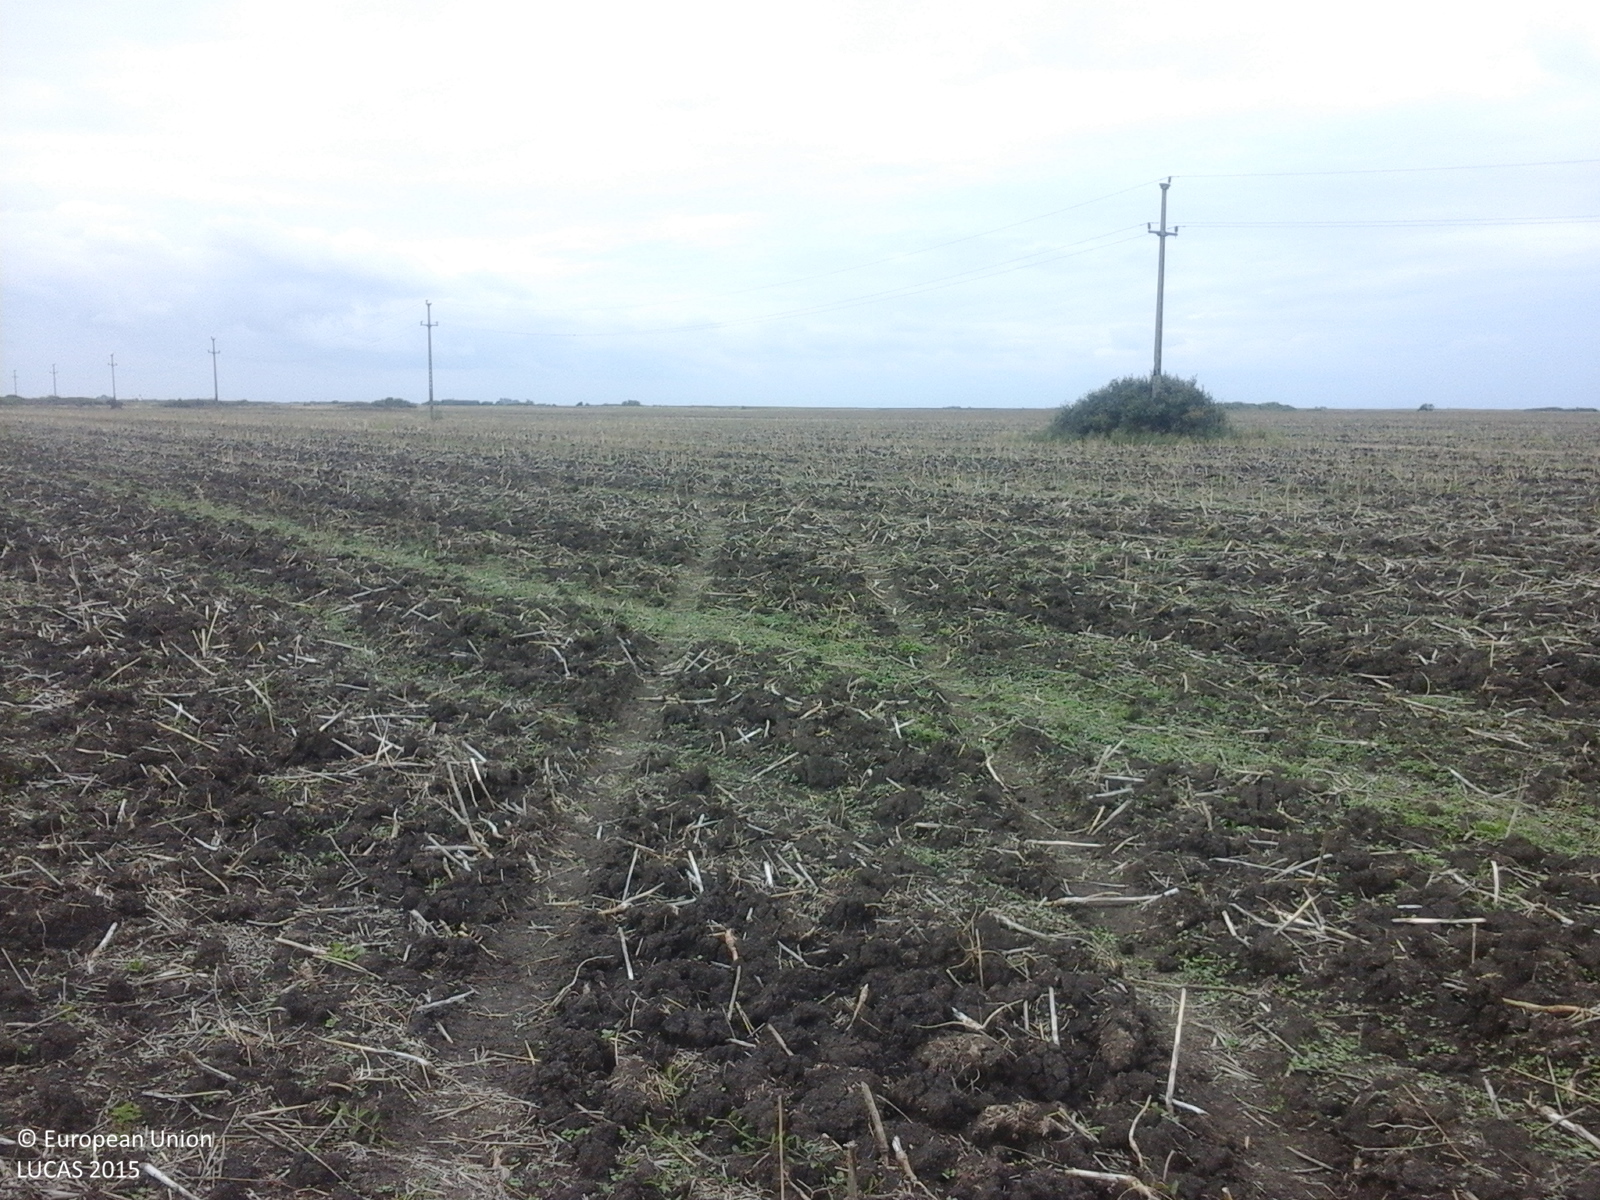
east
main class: Cropland
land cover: Rape and turnip rape
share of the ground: < 10 %
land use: Agriculture (excluding fallow land and kitchen gardens)
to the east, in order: Rape and turnip rape; Electric lines; Rape and turnip rape; Tracks; Rape and turnip rape
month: August
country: RO
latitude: 45.4458
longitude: 21.0866
